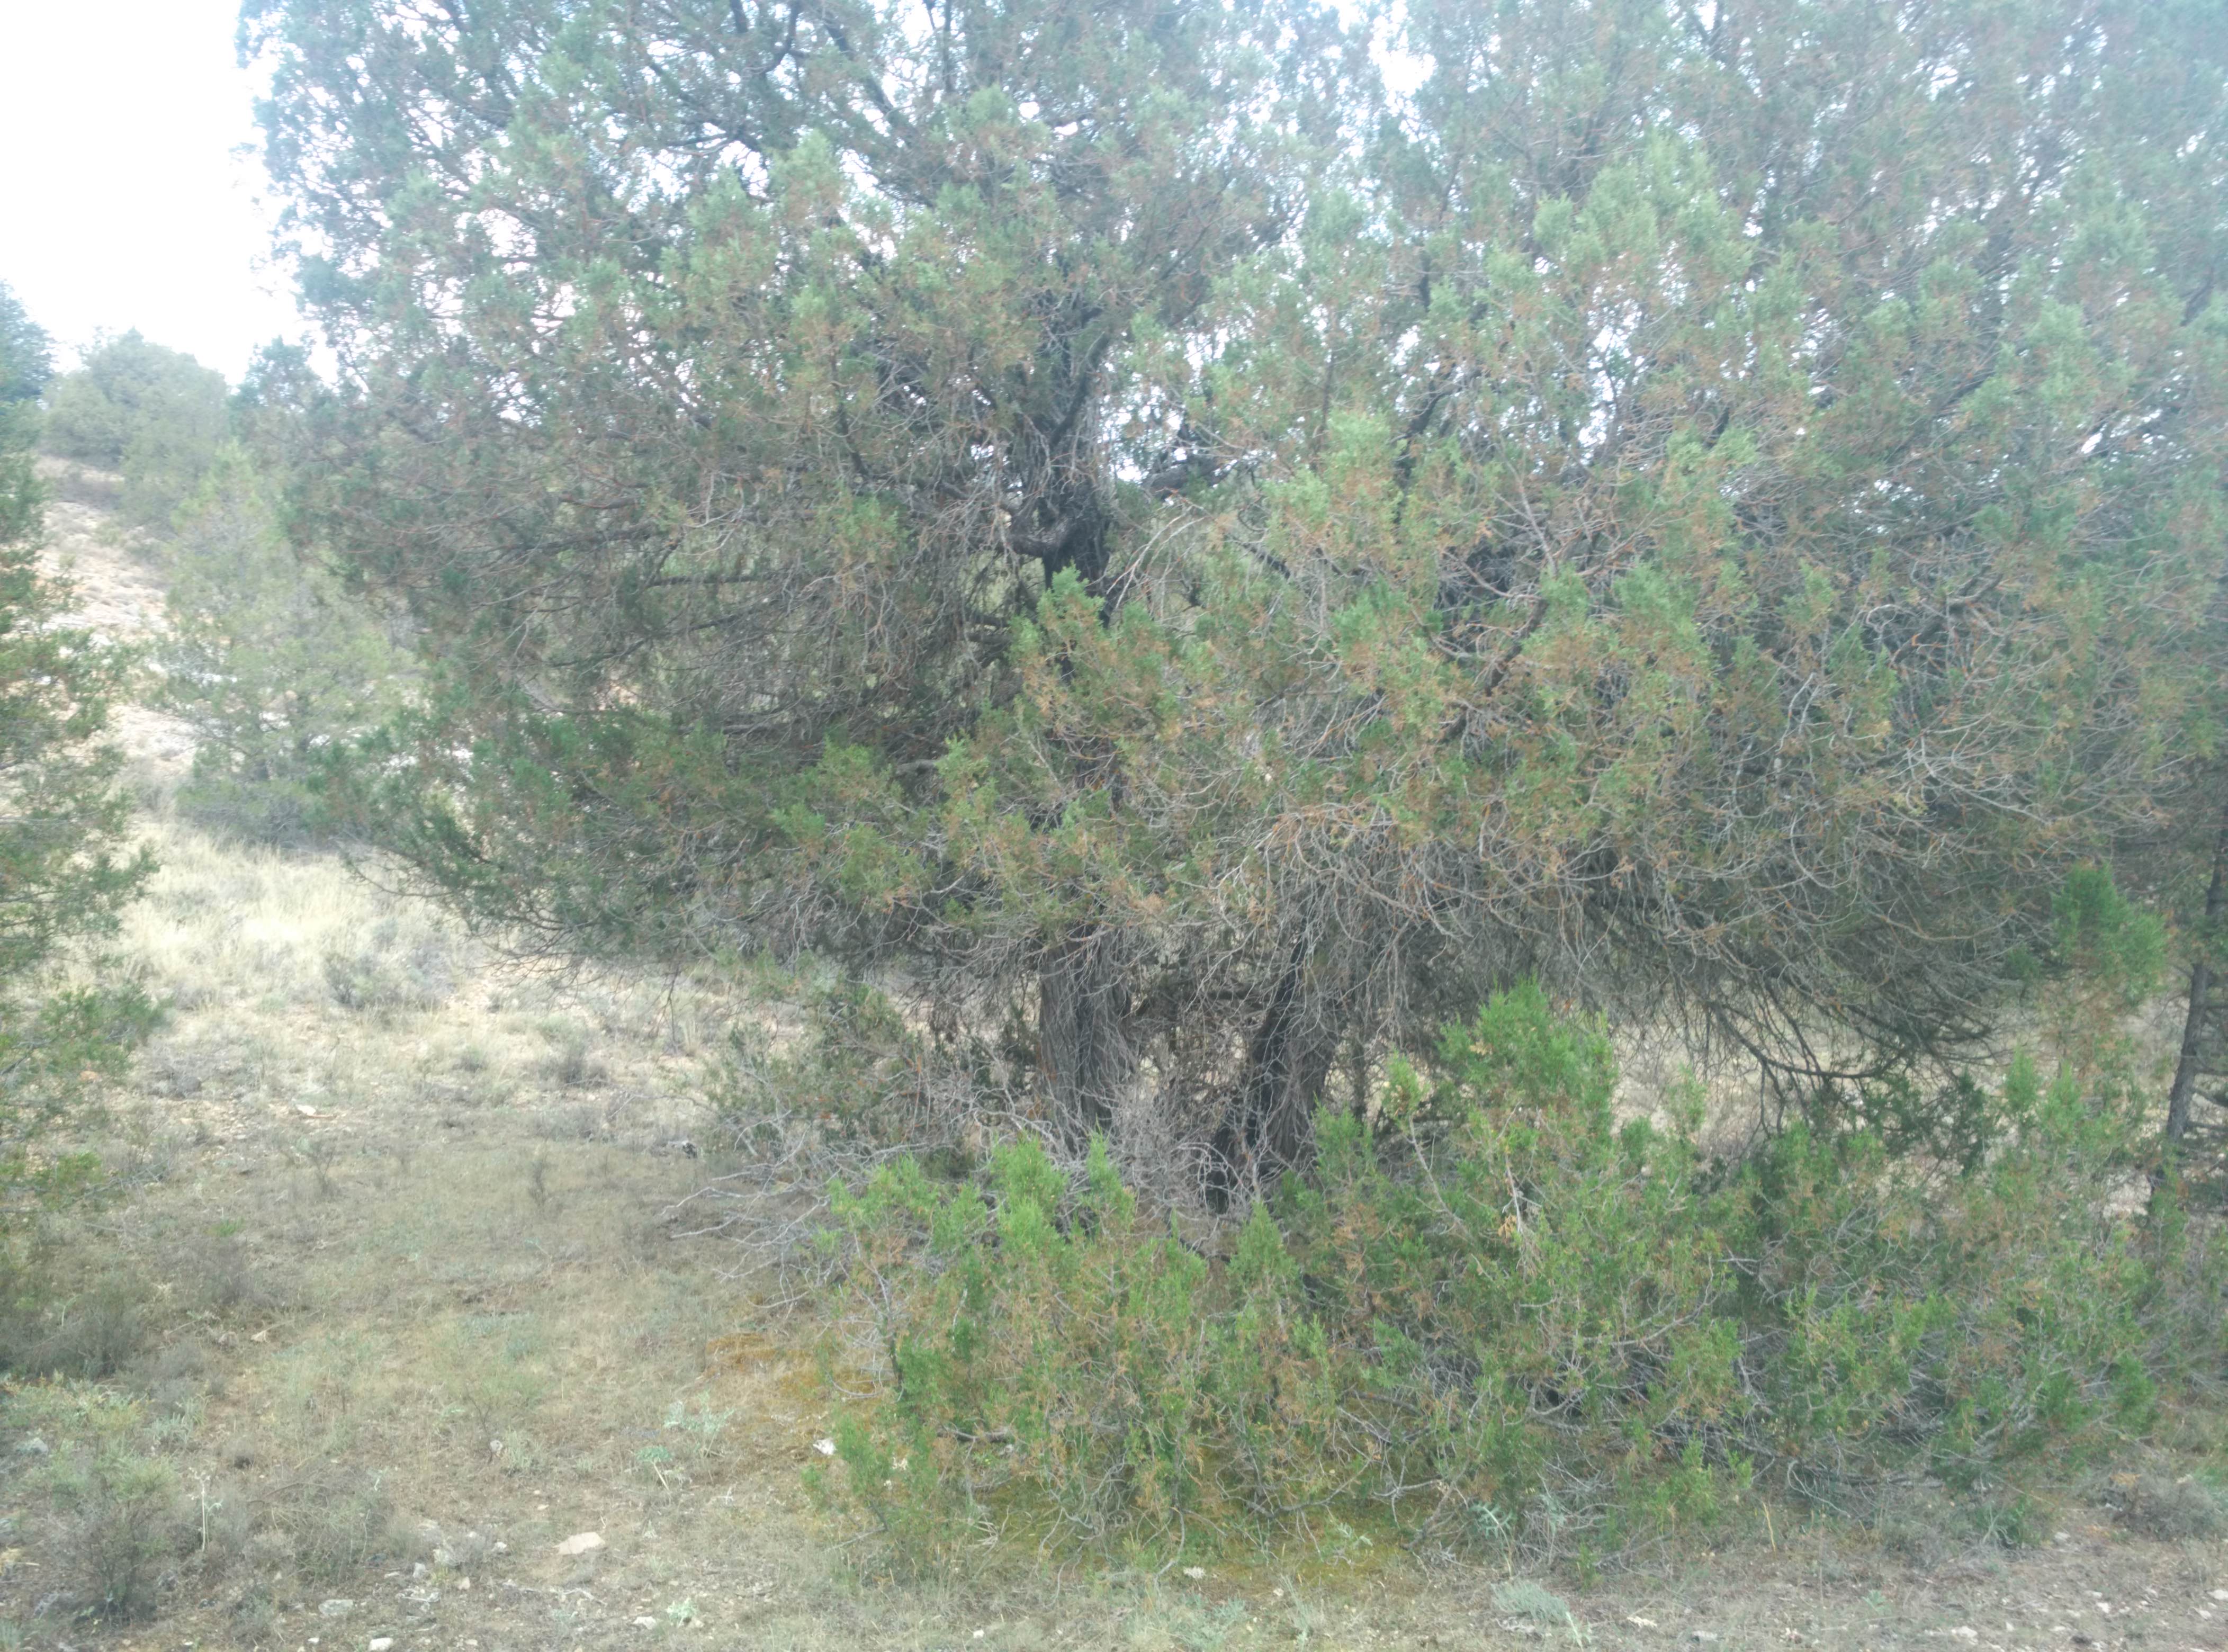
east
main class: Woodland
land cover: Other coniferous woodland
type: coniferous forest of the mediterranean region
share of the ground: 25 - 50 %
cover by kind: coniferous forest trees 40 %, herbaceous plants 30 %, unconsolidated bare surface 30 %
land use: Semi-natural and natural areas not in use
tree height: > 5 m
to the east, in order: Other coniferous woodland
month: July
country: ES
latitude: 40.7999
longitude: -2.0538
